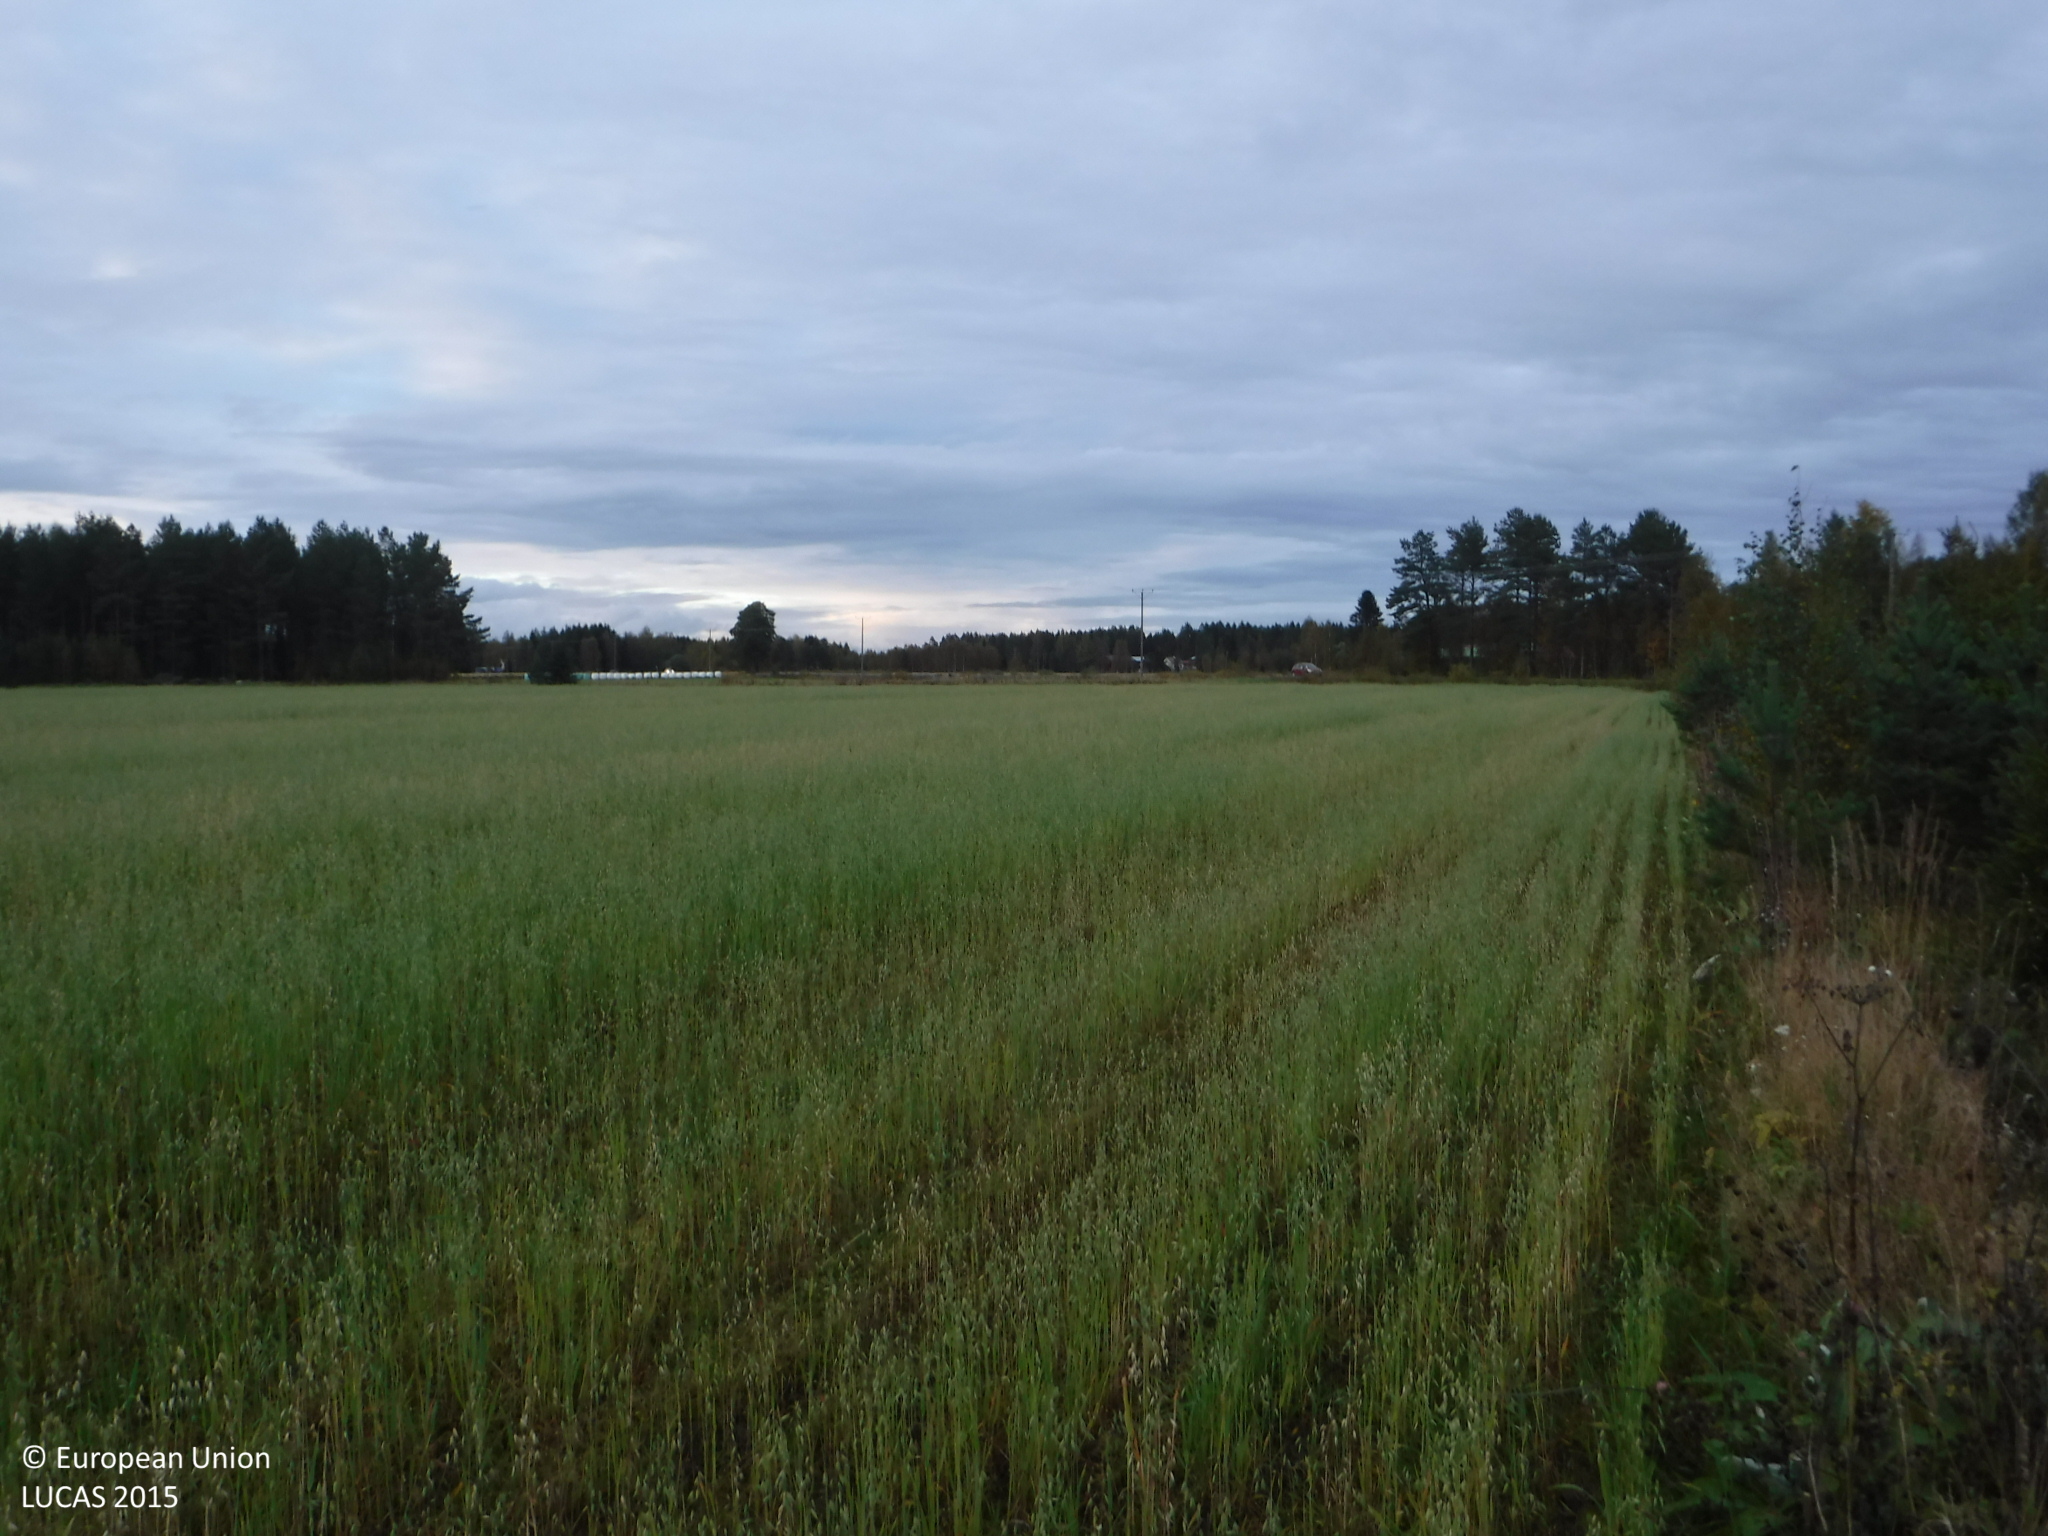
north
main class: Cropland
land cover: Oats
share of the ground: 50 - 75 %
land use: Agriculture (excluding fallow land and kitchen gardens)
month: September
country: FI
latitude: 62.0516
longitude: 22.5105
